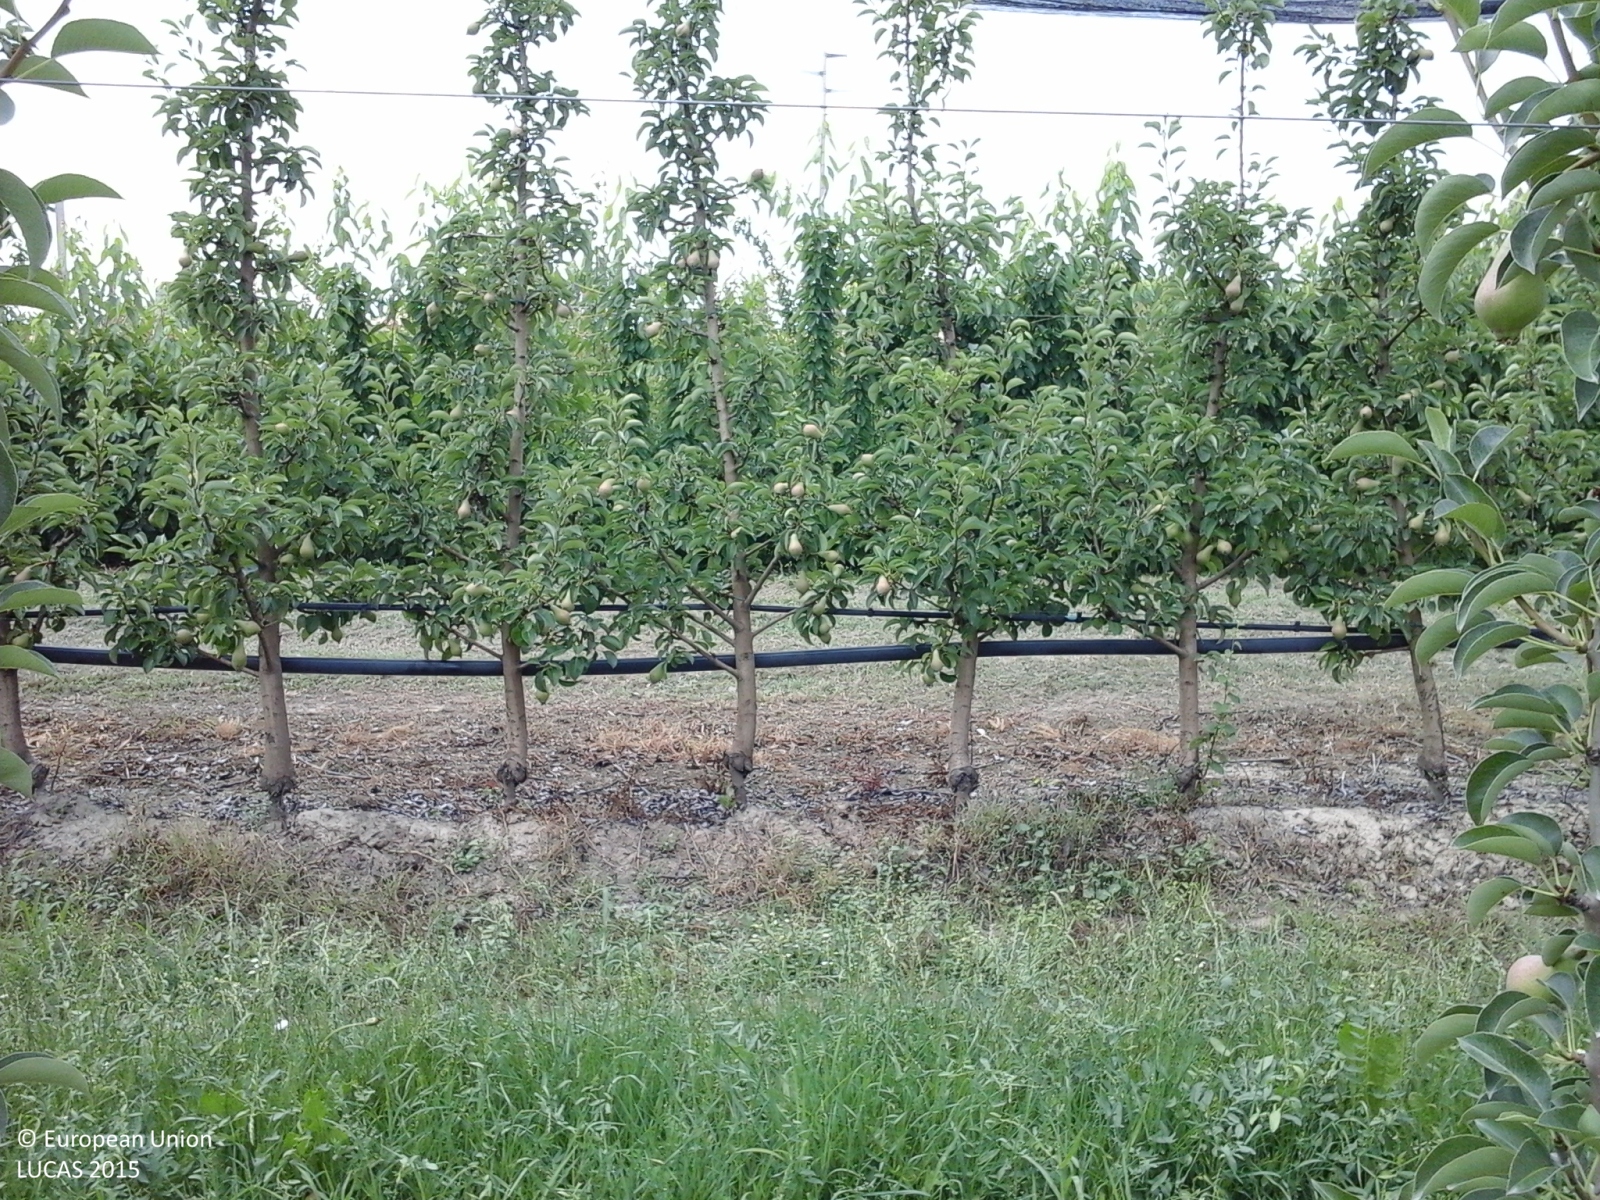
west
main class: Cropland
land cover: Pear fruit
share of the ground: 25 - 50 %
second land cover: Grassland without tree/shrub cover
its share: > 75 %
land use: Agriculture (excluding fallow land and kitchen gardens)
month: June
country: IT
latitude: 44.8764
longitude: 11.7814
